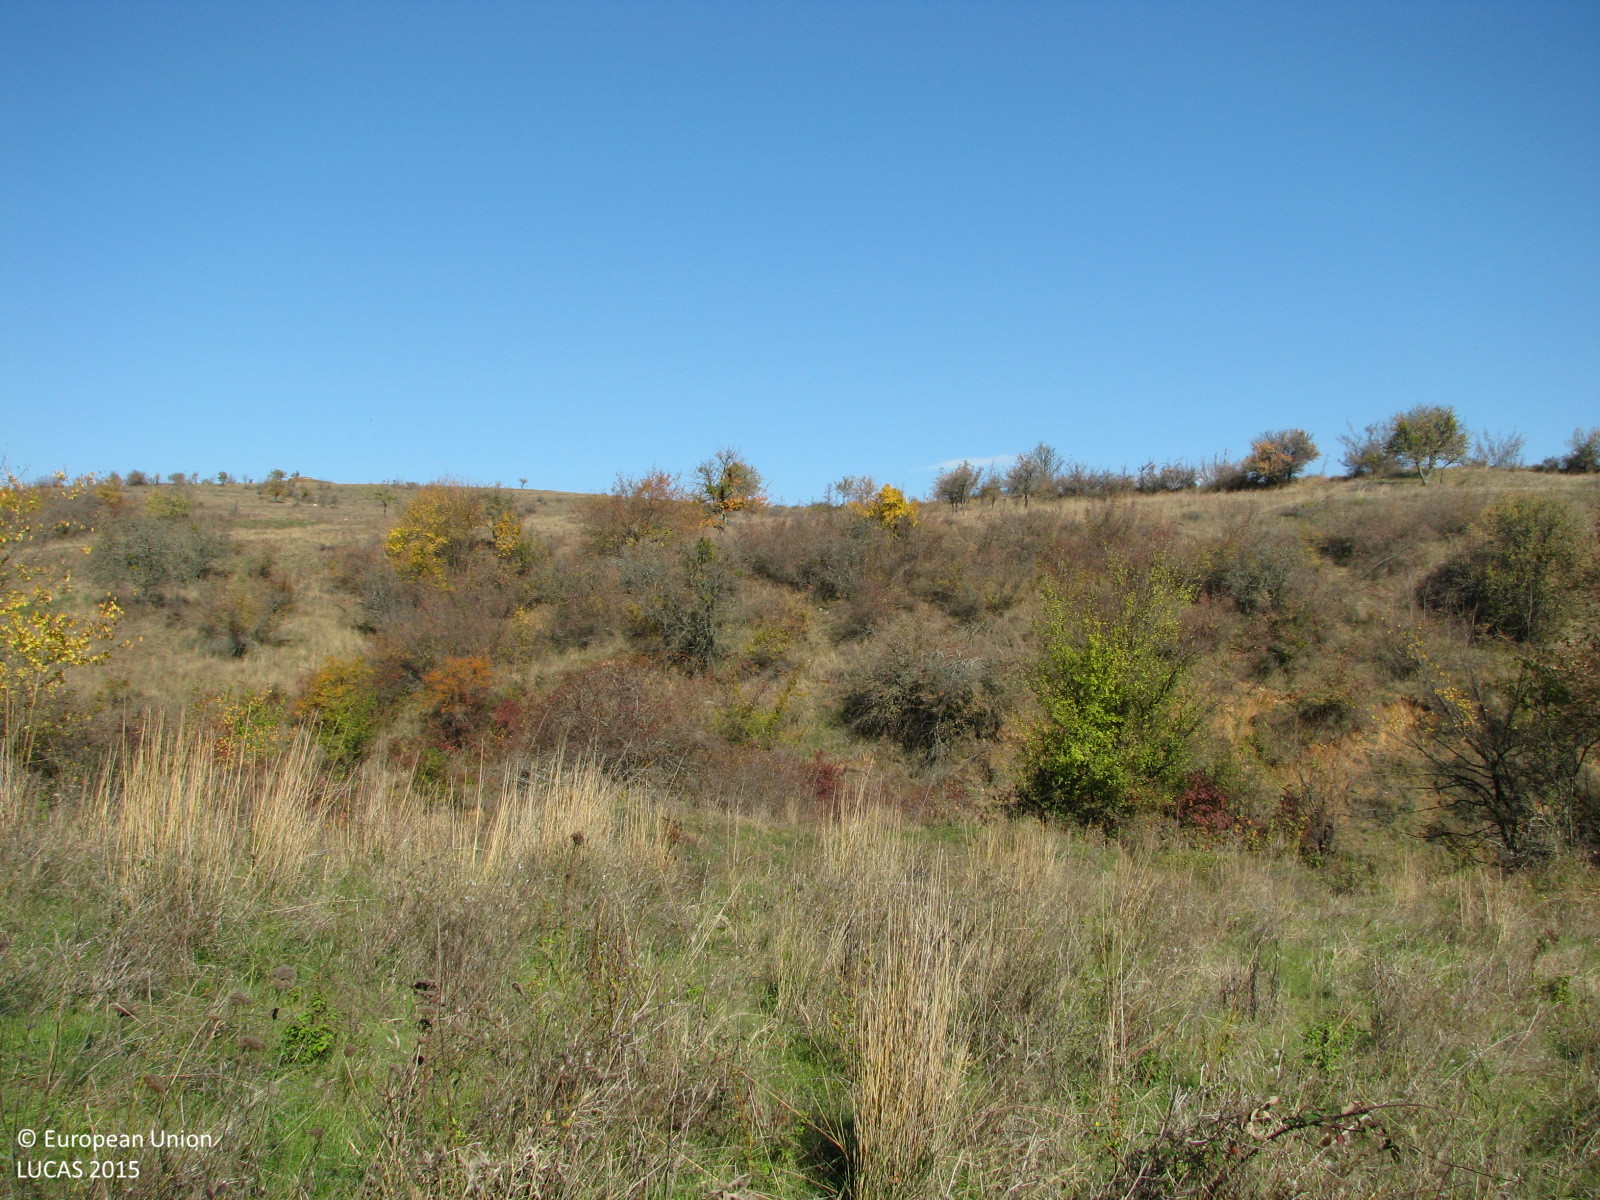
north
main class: Grassland
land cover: Grassland with sparse tree/shrub cover
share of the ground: > 75 %
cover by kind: herbaceous plants 90 %, broadleaved forest trees 5 %, shrubs 5 %
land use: Agriculture (excluding fallow land and kitchen gardens)
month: November
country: BG
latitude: 41.8968
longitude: 26.3899
